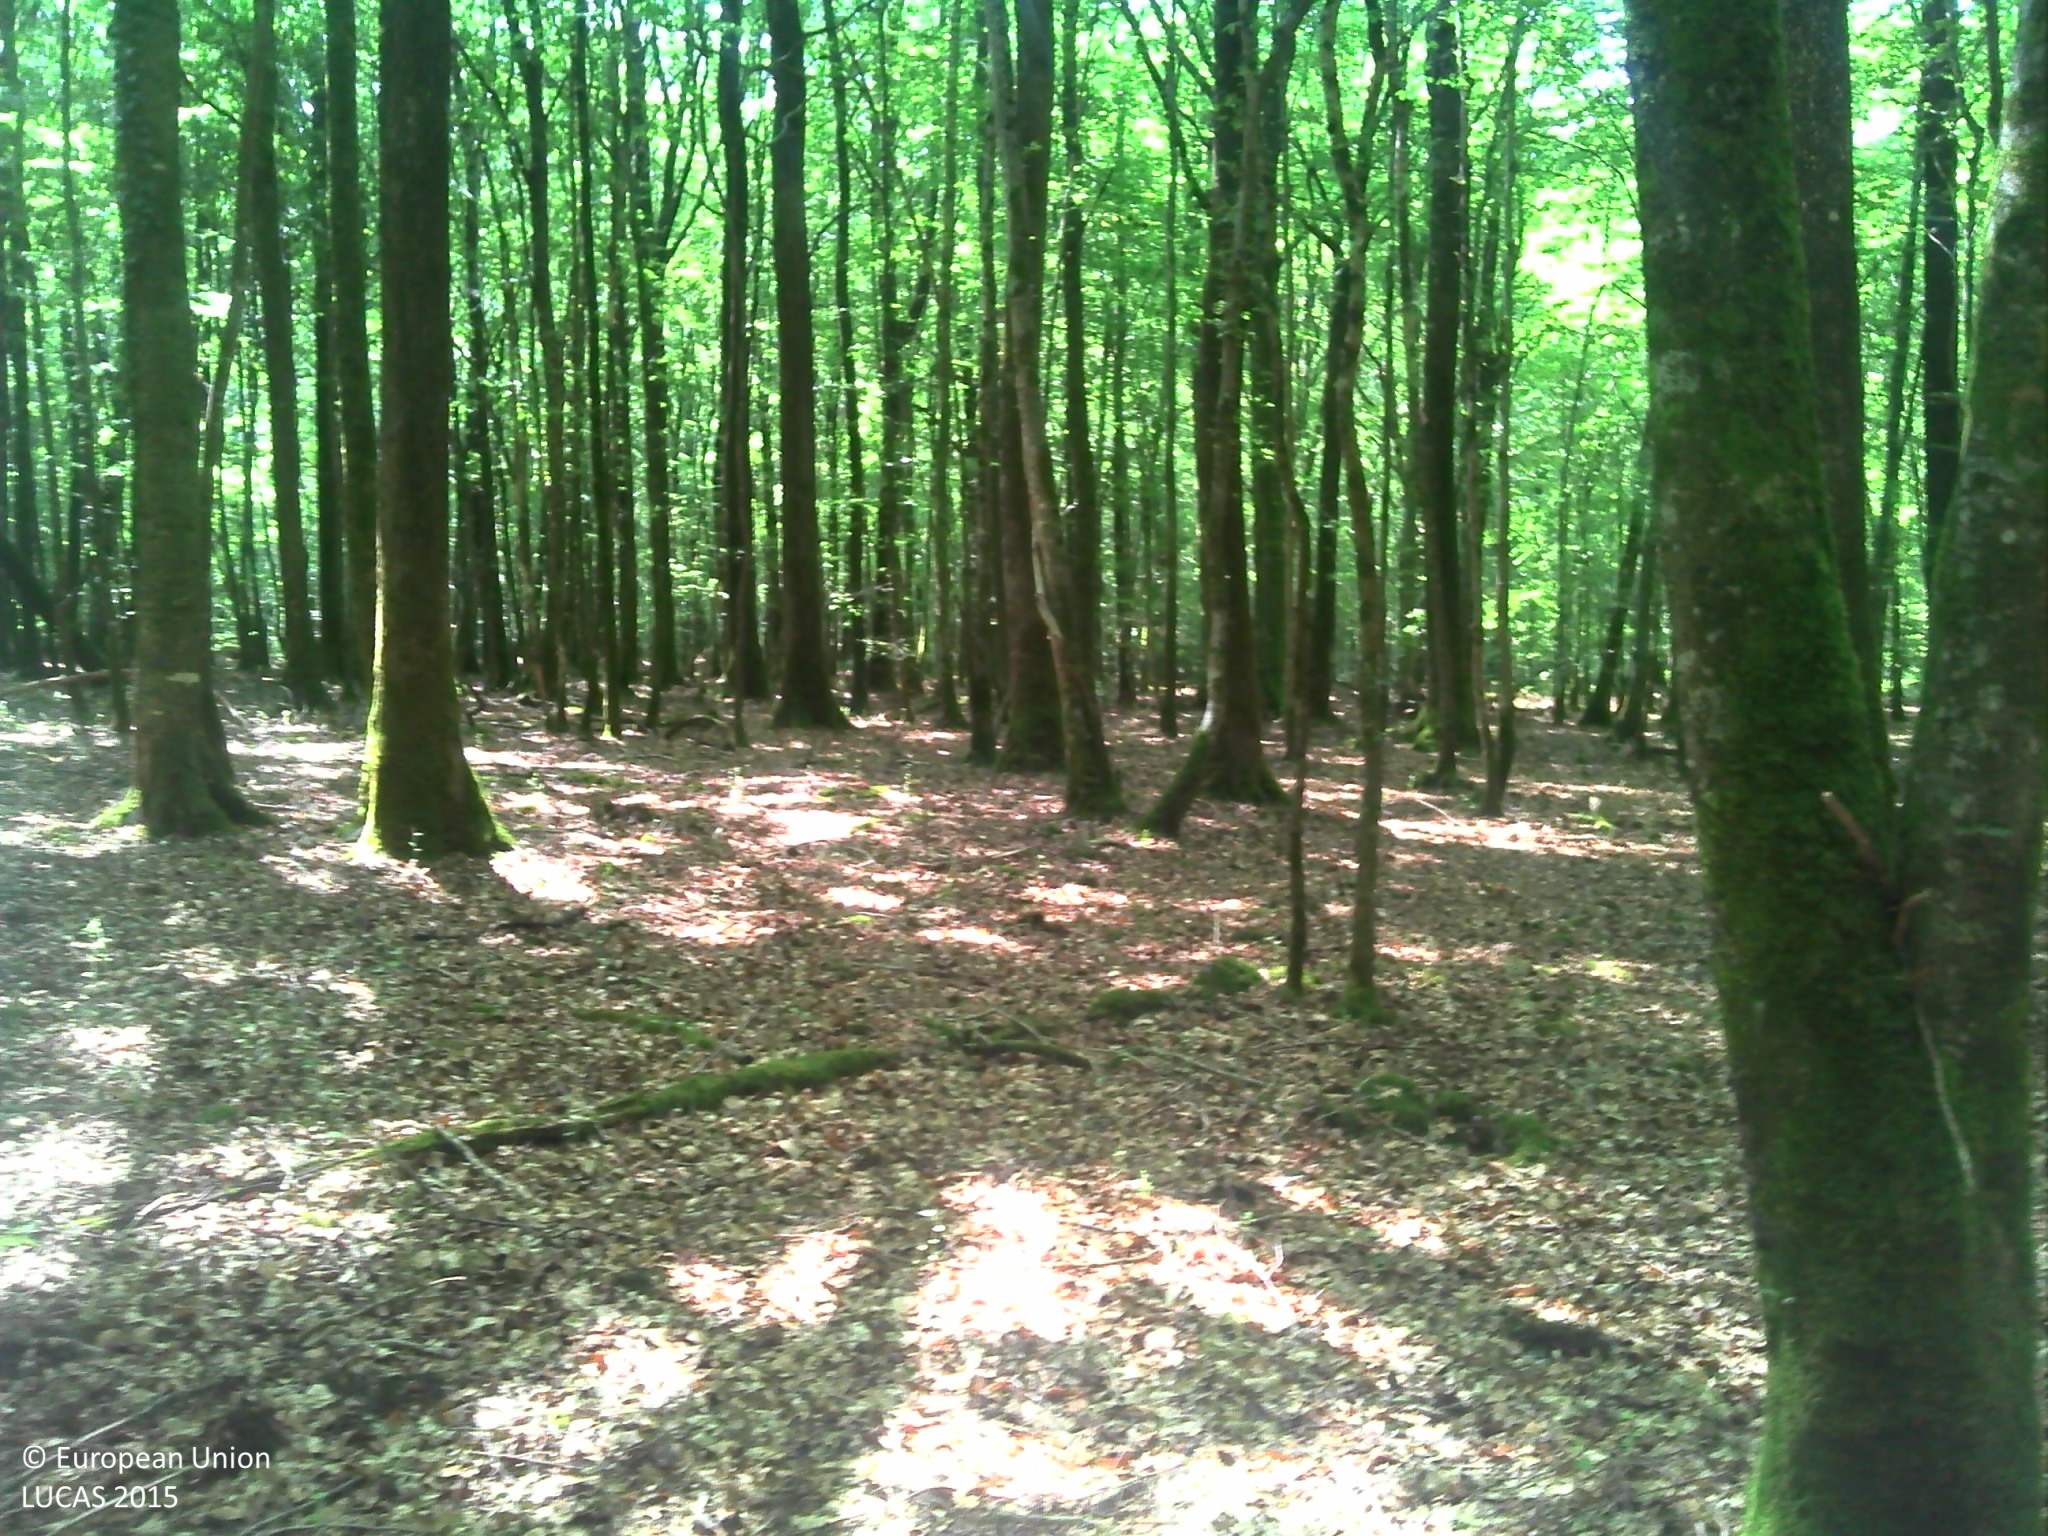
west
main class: Woodland
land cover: Broadleaved woodland
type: acidophilous oak and oak-birch forest
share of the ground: > 75 %
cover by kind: broadleaved forest trees 90 %, herbaceous plants 5 %, lichens and mosses 5 %
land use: Forestry
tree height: > 5 m
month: July
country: FR
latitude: 48.1147
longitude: 0.8588
